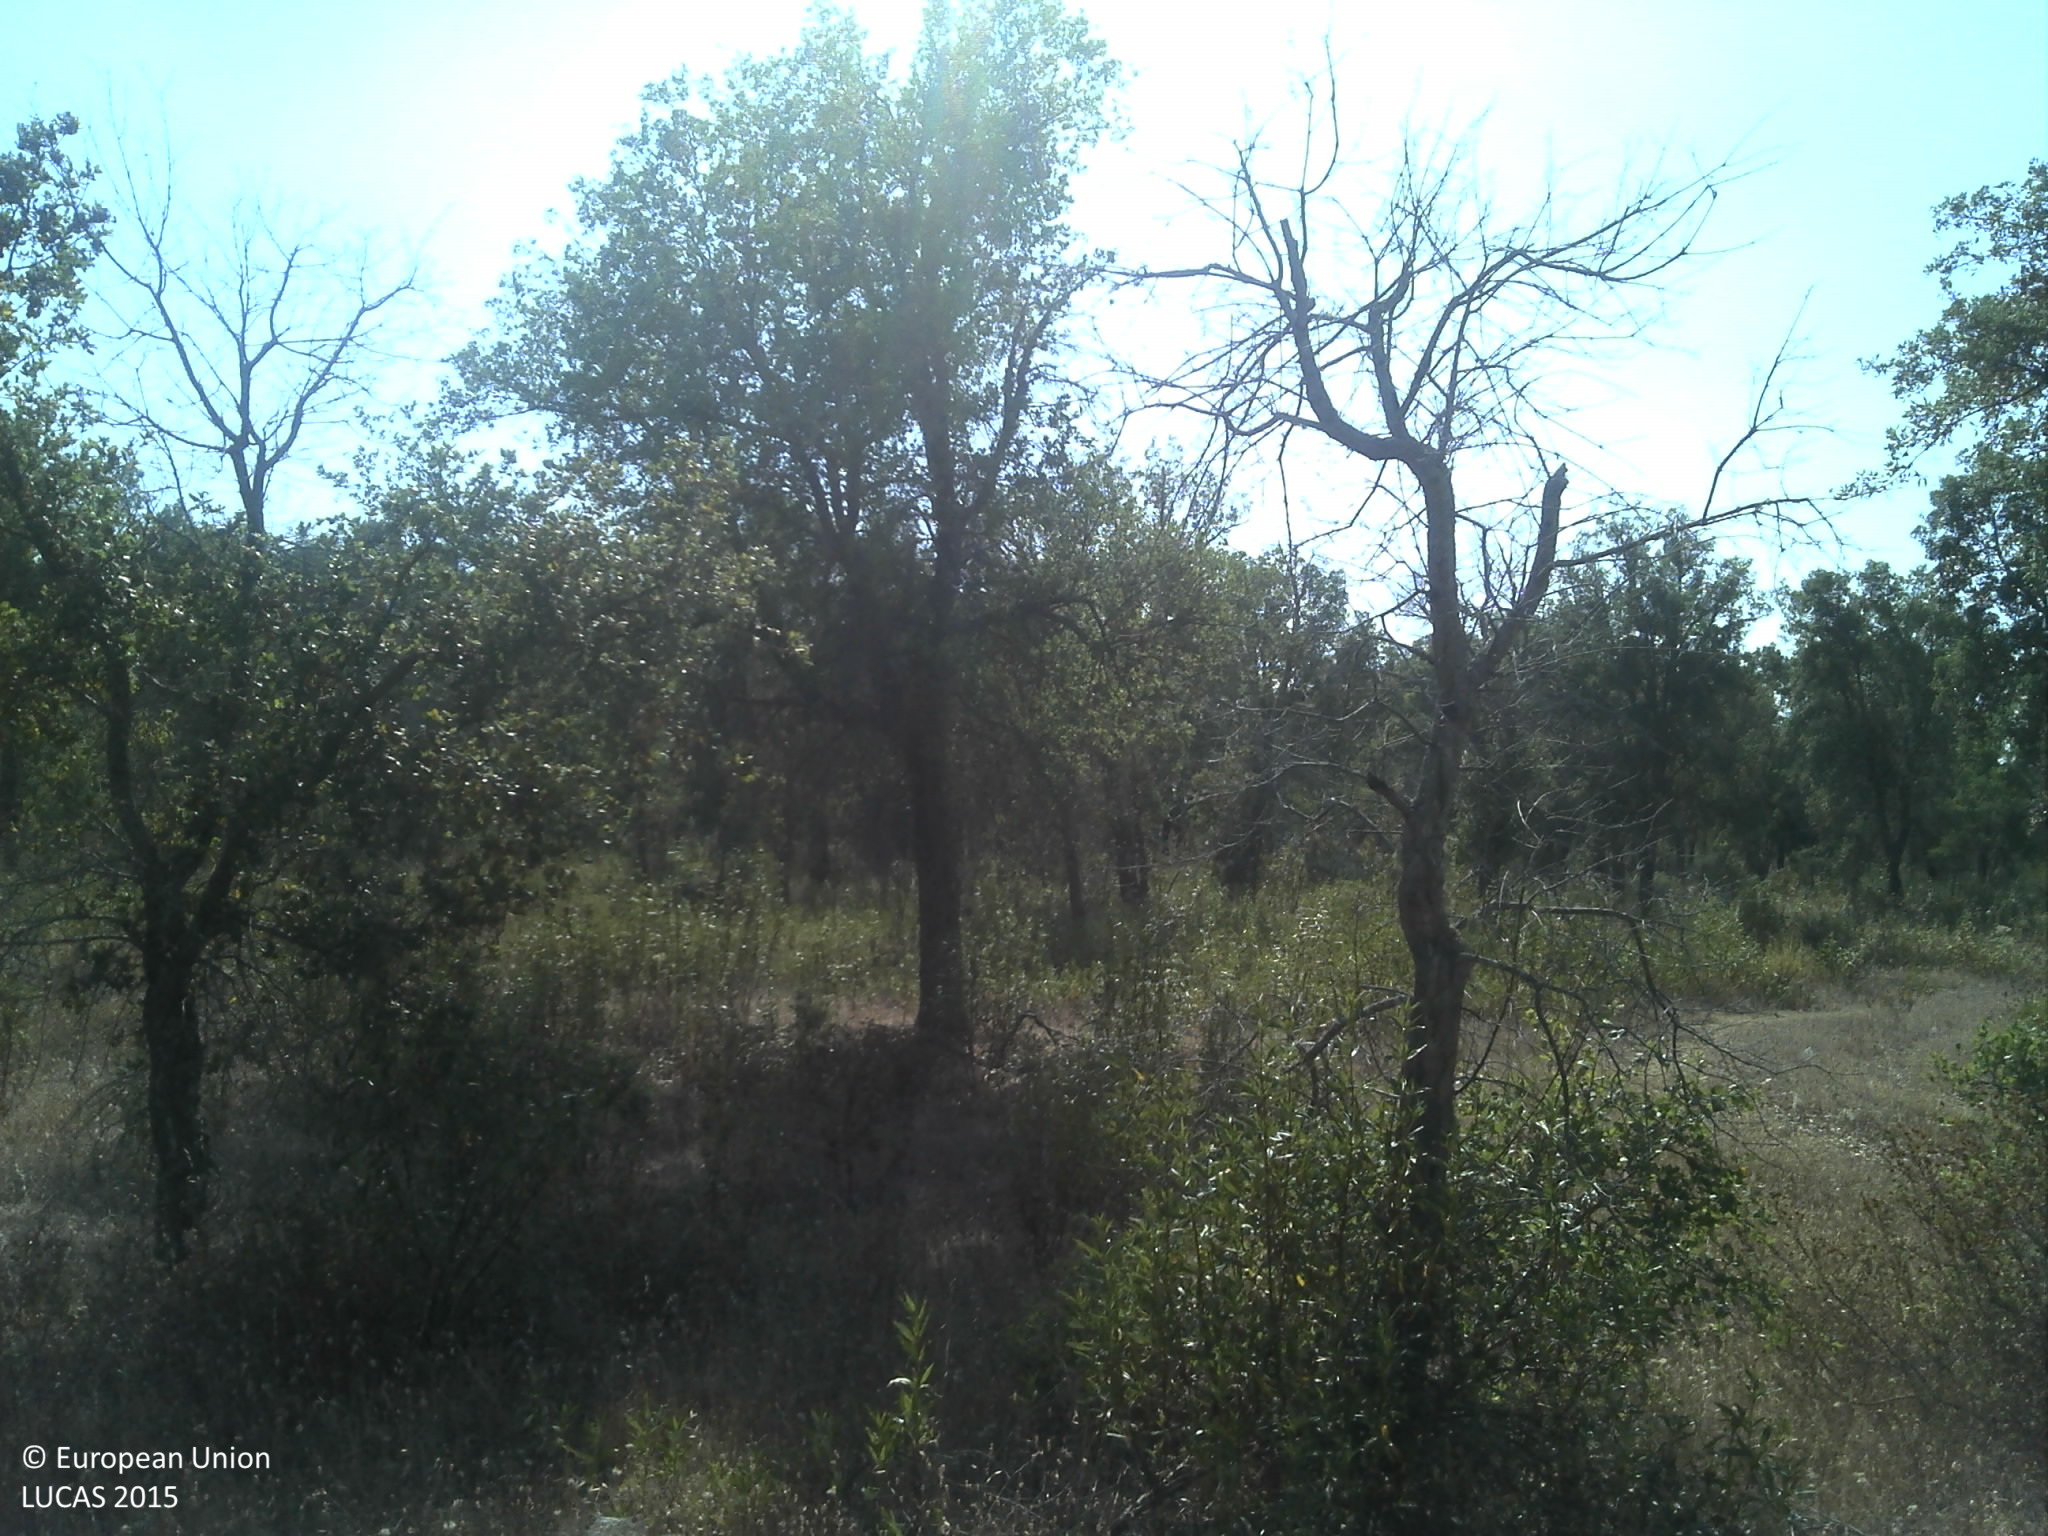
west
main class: Woodland
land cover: Broadleaved woodland
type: broadleaved evergreen forest
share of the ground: 10 - 25 %
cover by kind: shrubs 40 %, broadleaved forest trees 25 %, herbaceous plants 20 %, unconsolidated bare surface 15 %
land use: Forestry
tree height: > 5 m
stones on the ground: 10 - 25 %
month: June
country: PT
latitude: 39.4005
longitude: -7.9985
